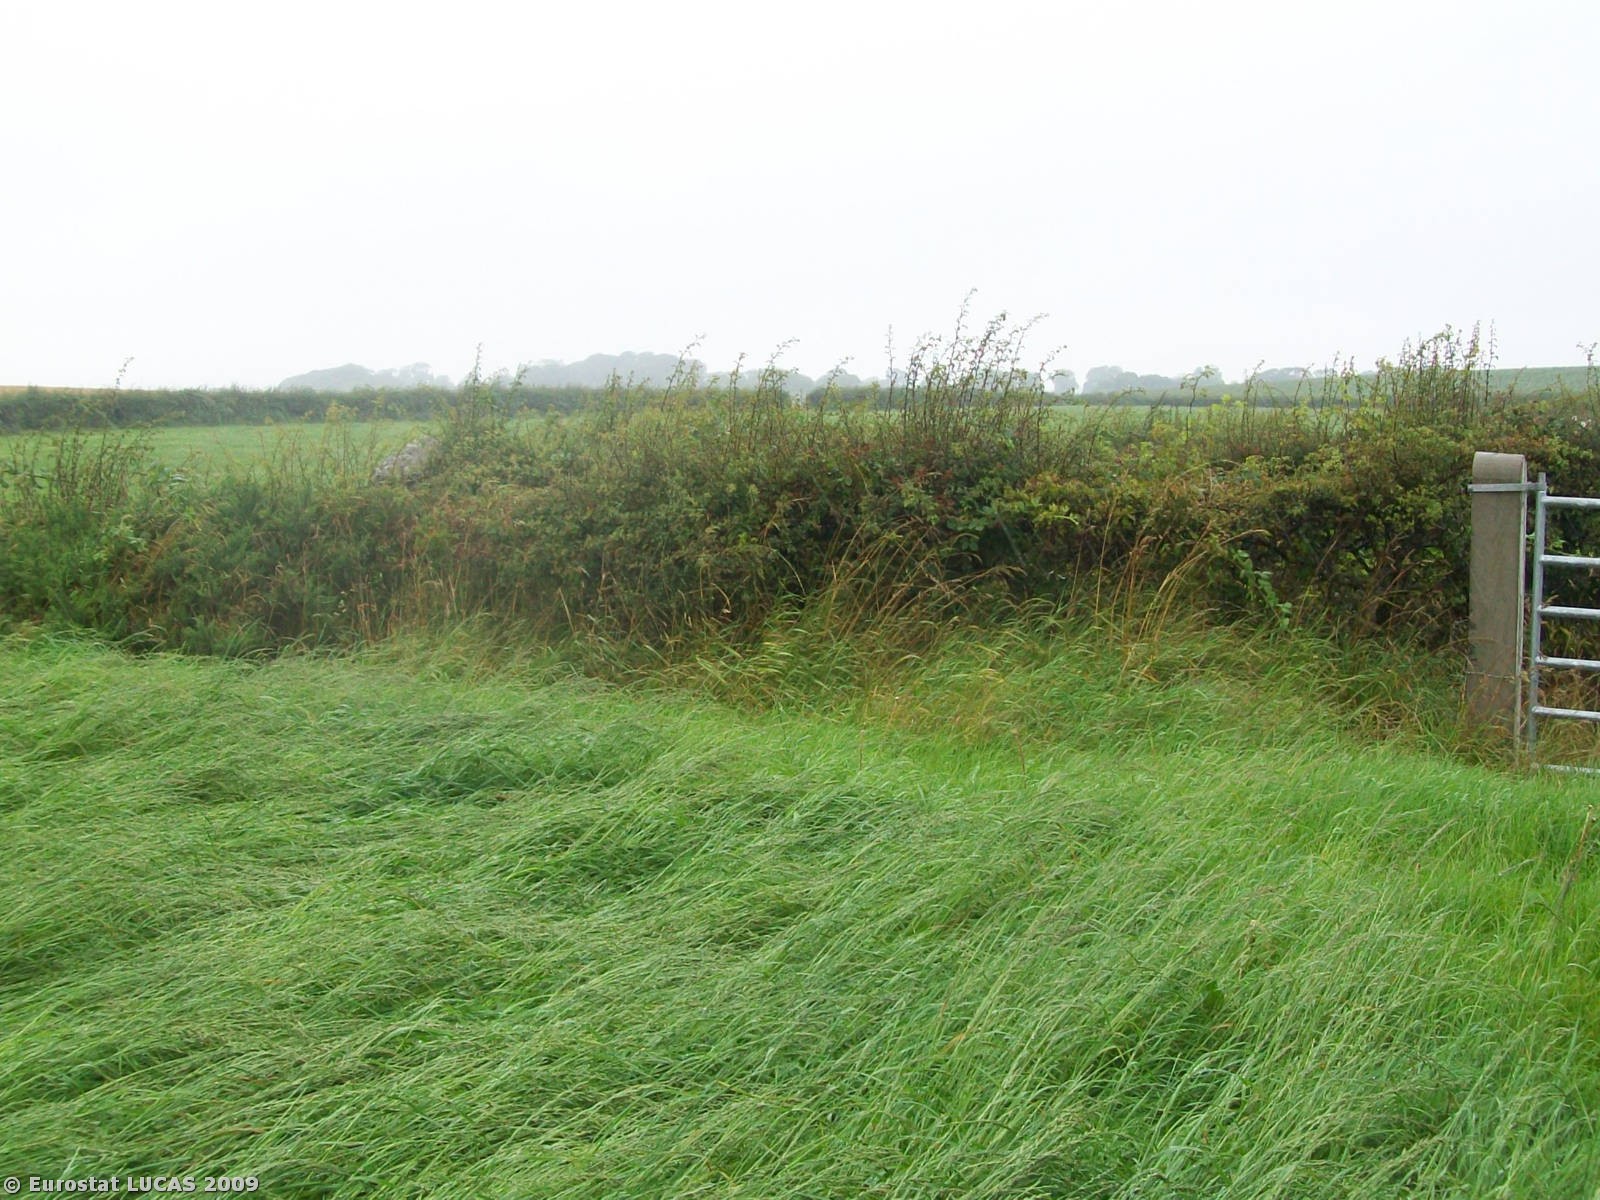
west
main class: Grassland
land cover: Grassland without tree/shrub cover
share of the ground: > 75 %
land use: Agriculture (excluding fallow land and kitchen gardens)
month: August
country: GB
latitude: 54.2852
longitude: -5.6304
